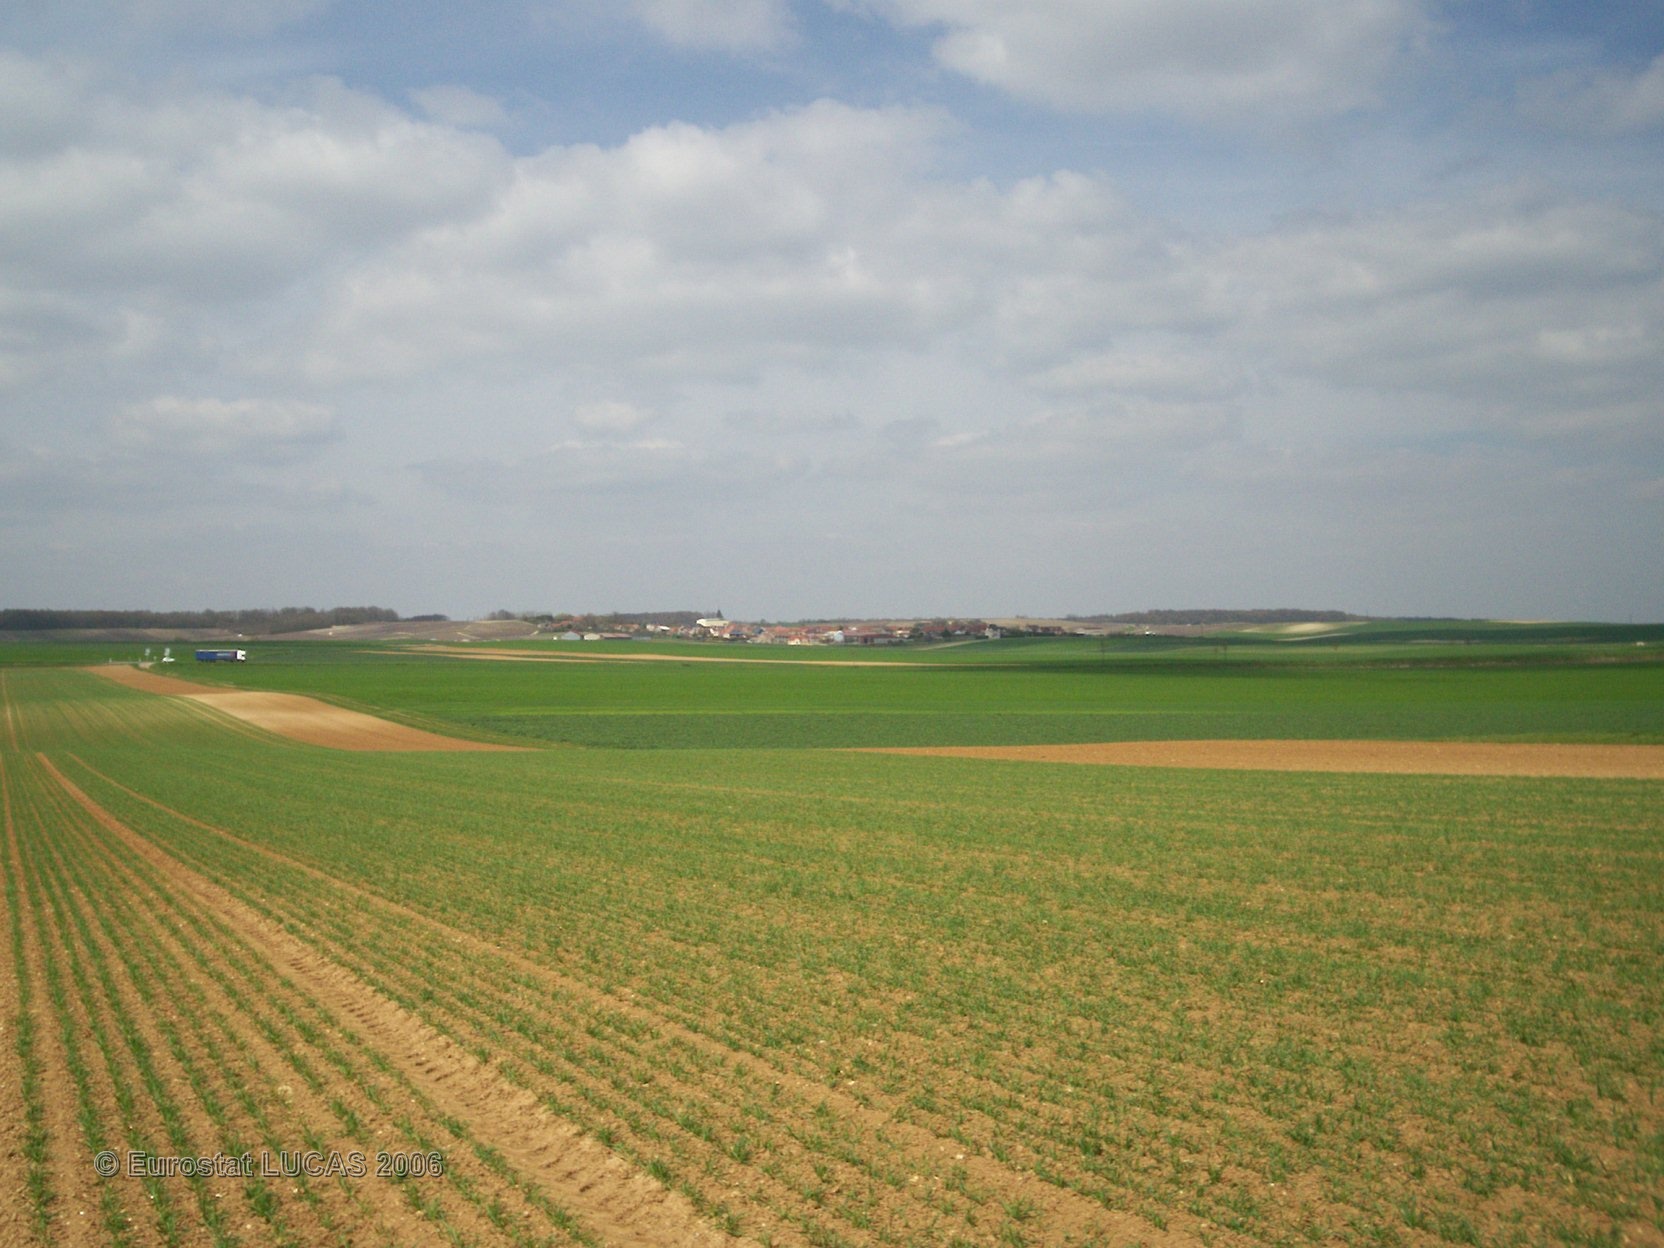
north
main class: Cropland
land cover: Barley
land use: Agriculture (excluding fallow land and kitchen gardens)
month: April
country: FR
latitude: 48.8666
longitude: 3.9013
